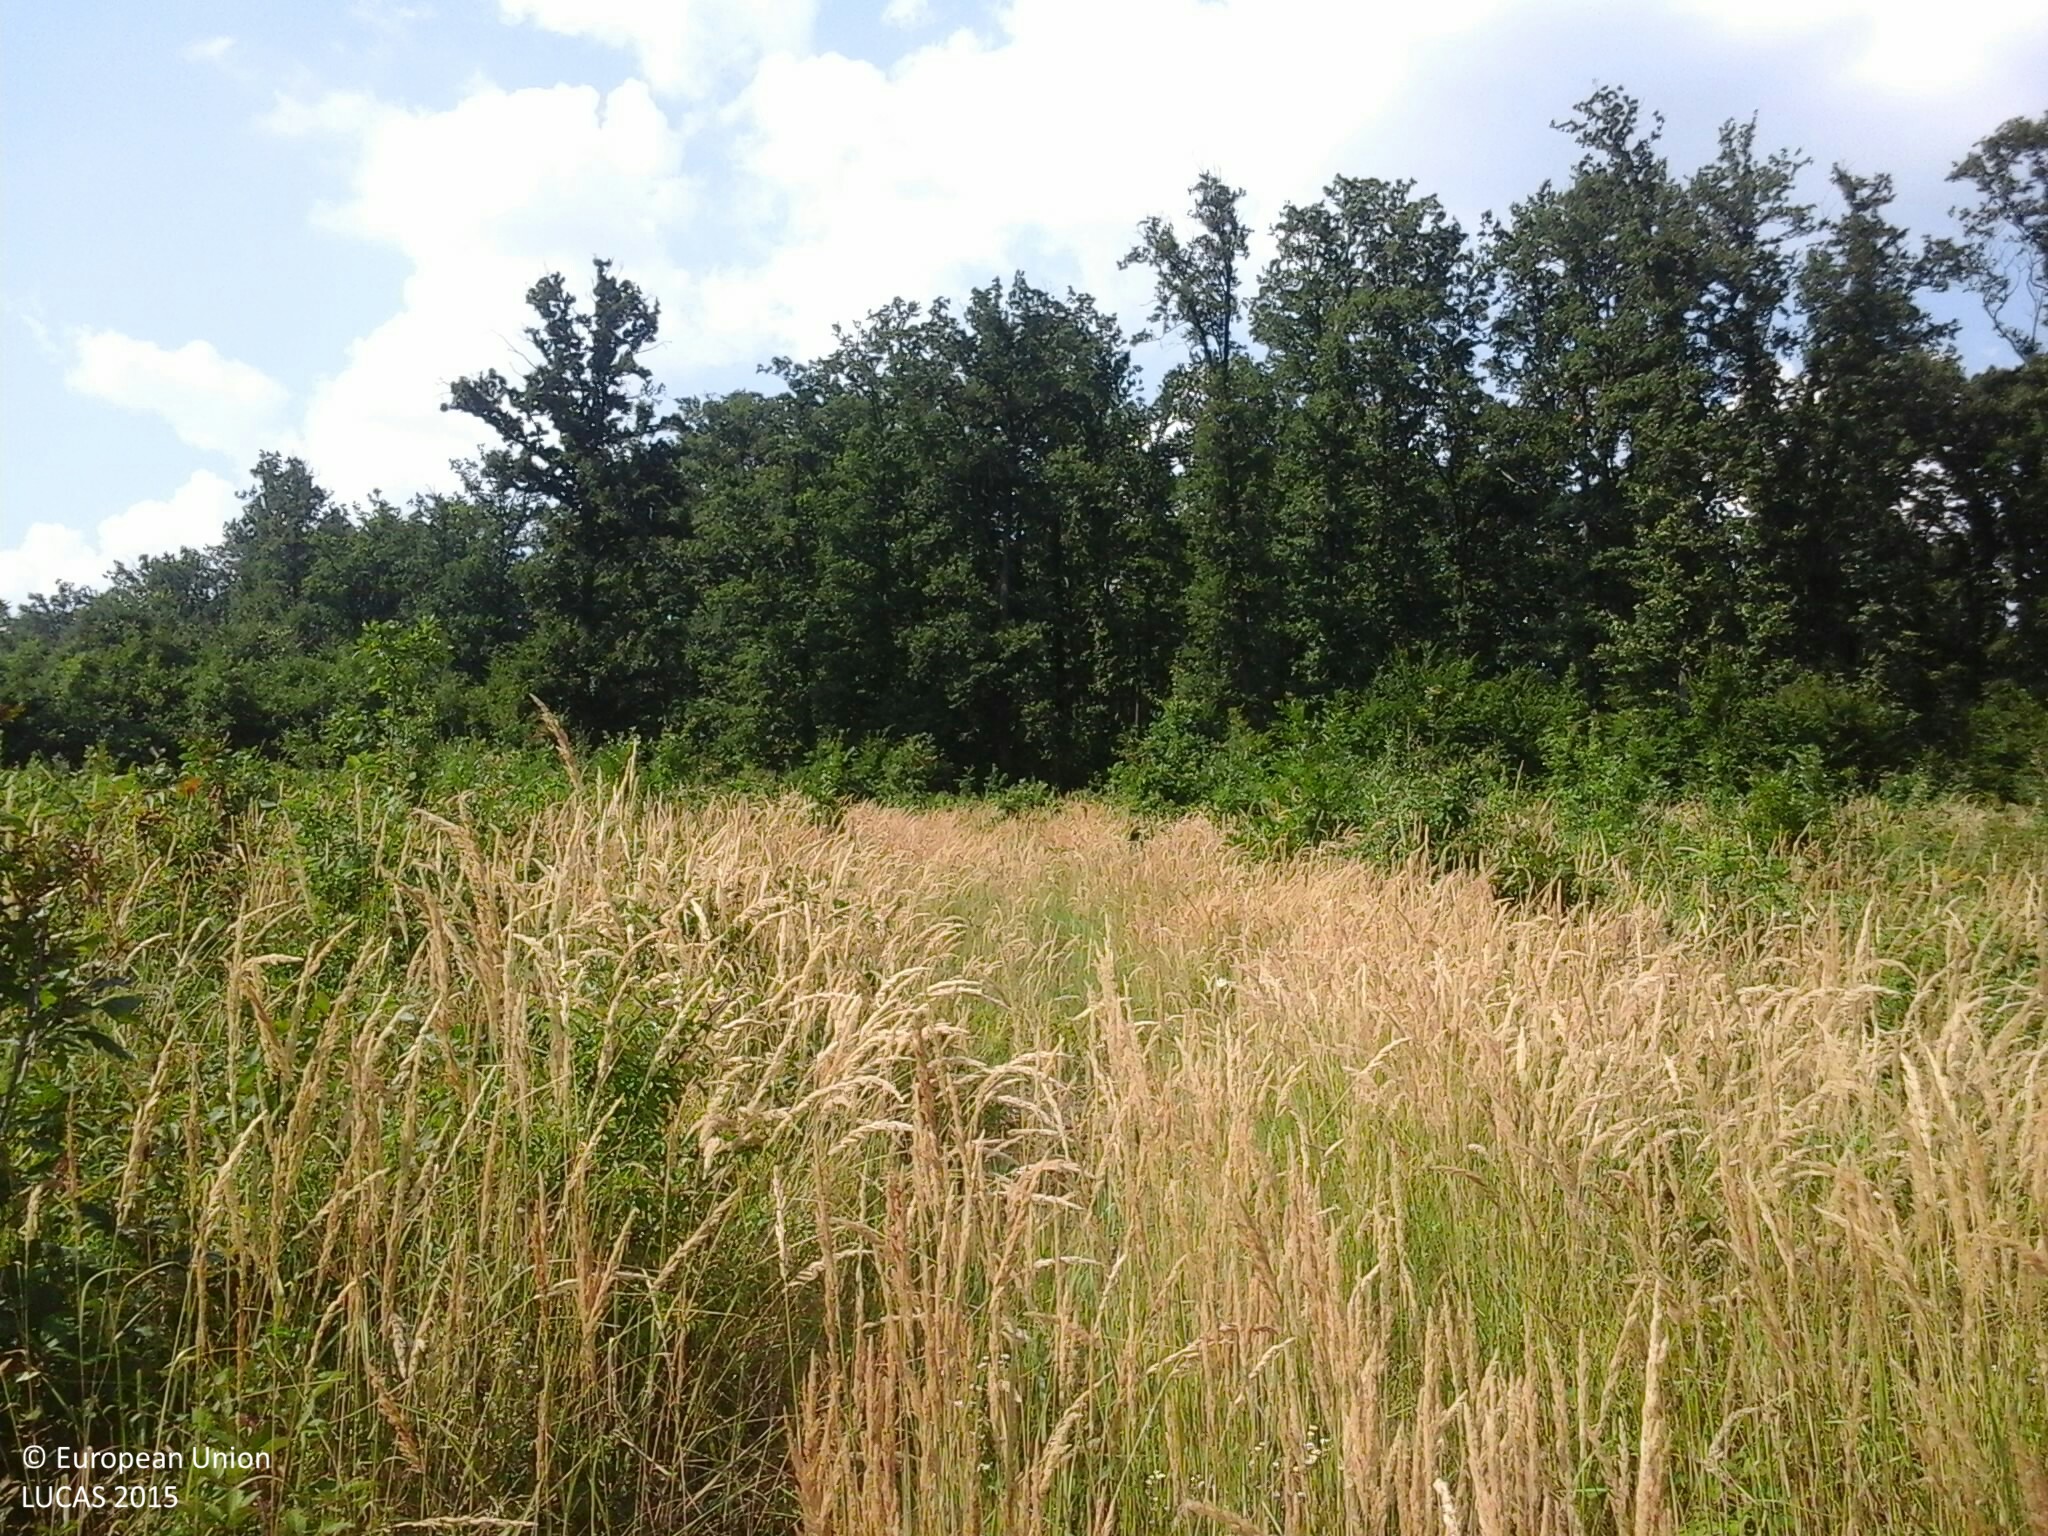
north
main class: Woodland
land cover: Broadleaved woodland
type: mesophytic deciduous forest
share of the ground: 50 - 75 %
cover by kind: broadleaved forest trees 50 %, herbaceous plants 30 %, shrubs 20 %
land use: Forestry
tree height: < 5 m
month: August
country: HU
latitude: 46.1384
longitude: 18.2794
